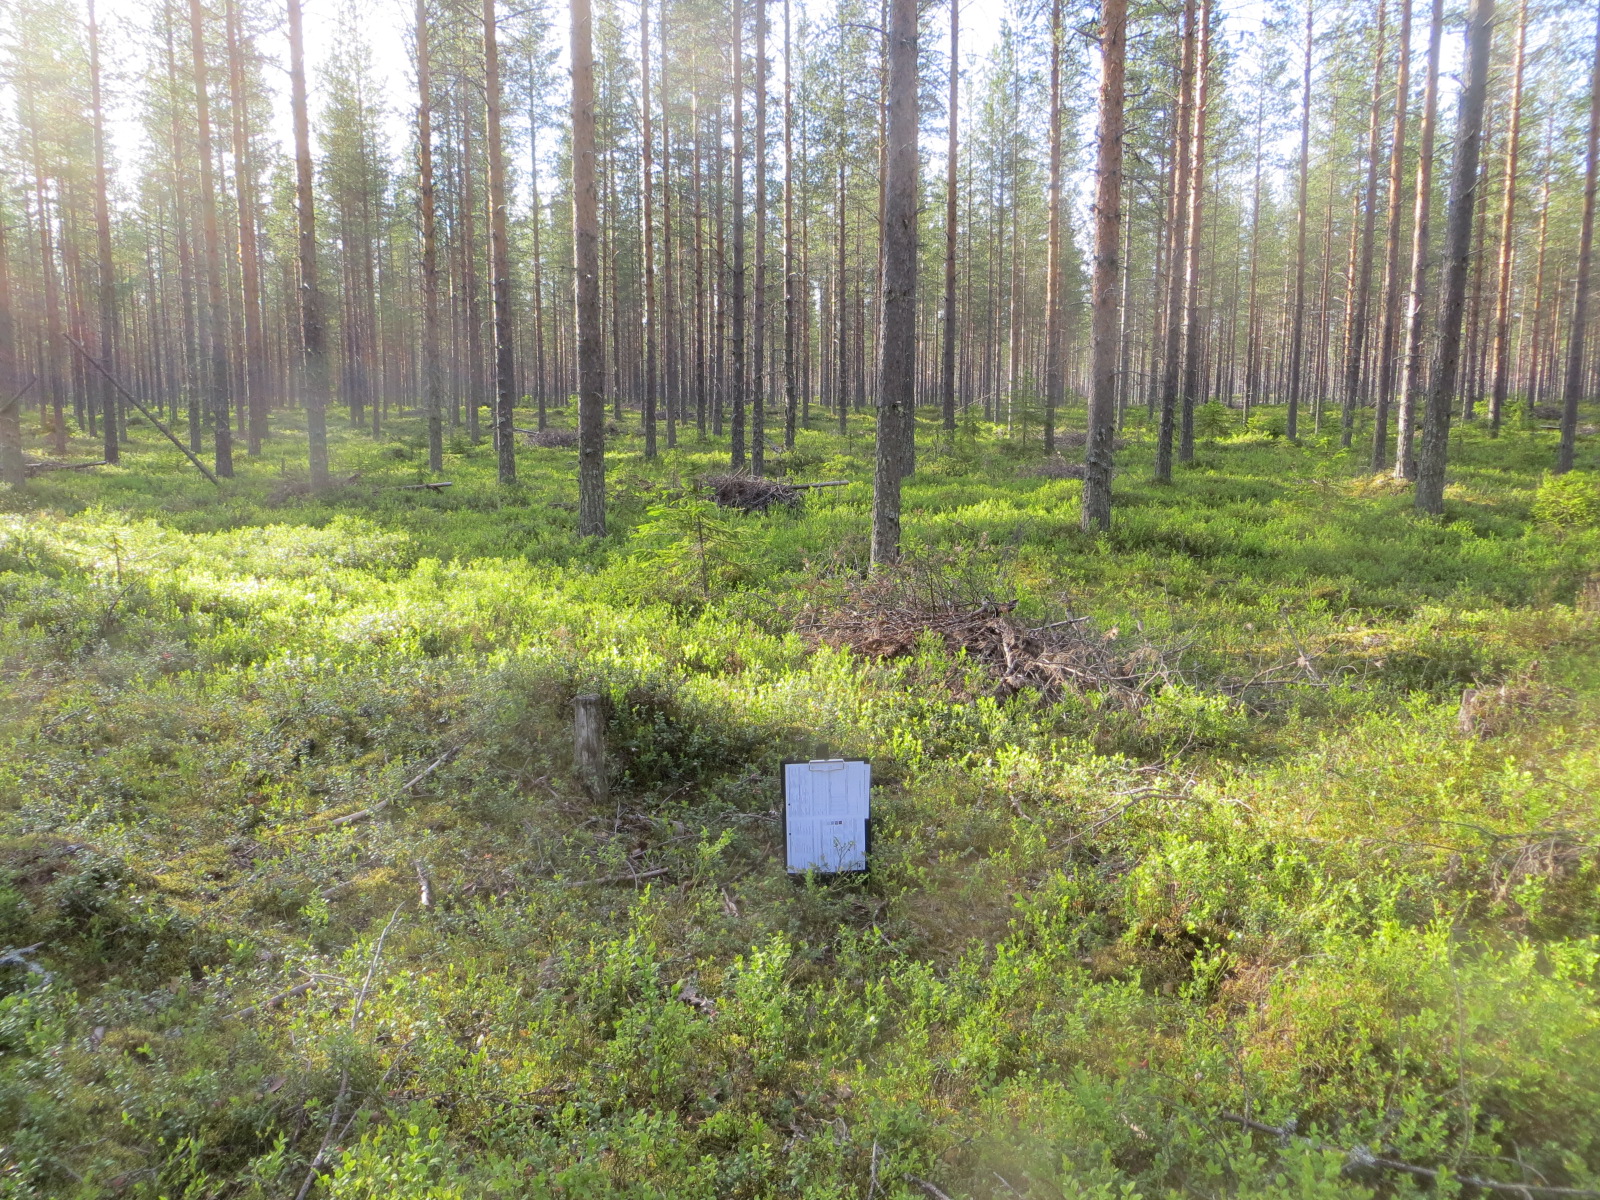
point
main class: Woodland
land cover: Pine dominated coniferous woodland
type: boreal forest
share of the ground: > 75 %
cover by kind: coniferous forest trees 75 %, shrubs 20 %, lichens and mosses 5 %
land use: Forestry
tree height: > 5 m
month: July
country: FI
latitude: 65.4268
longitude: 26.4142
